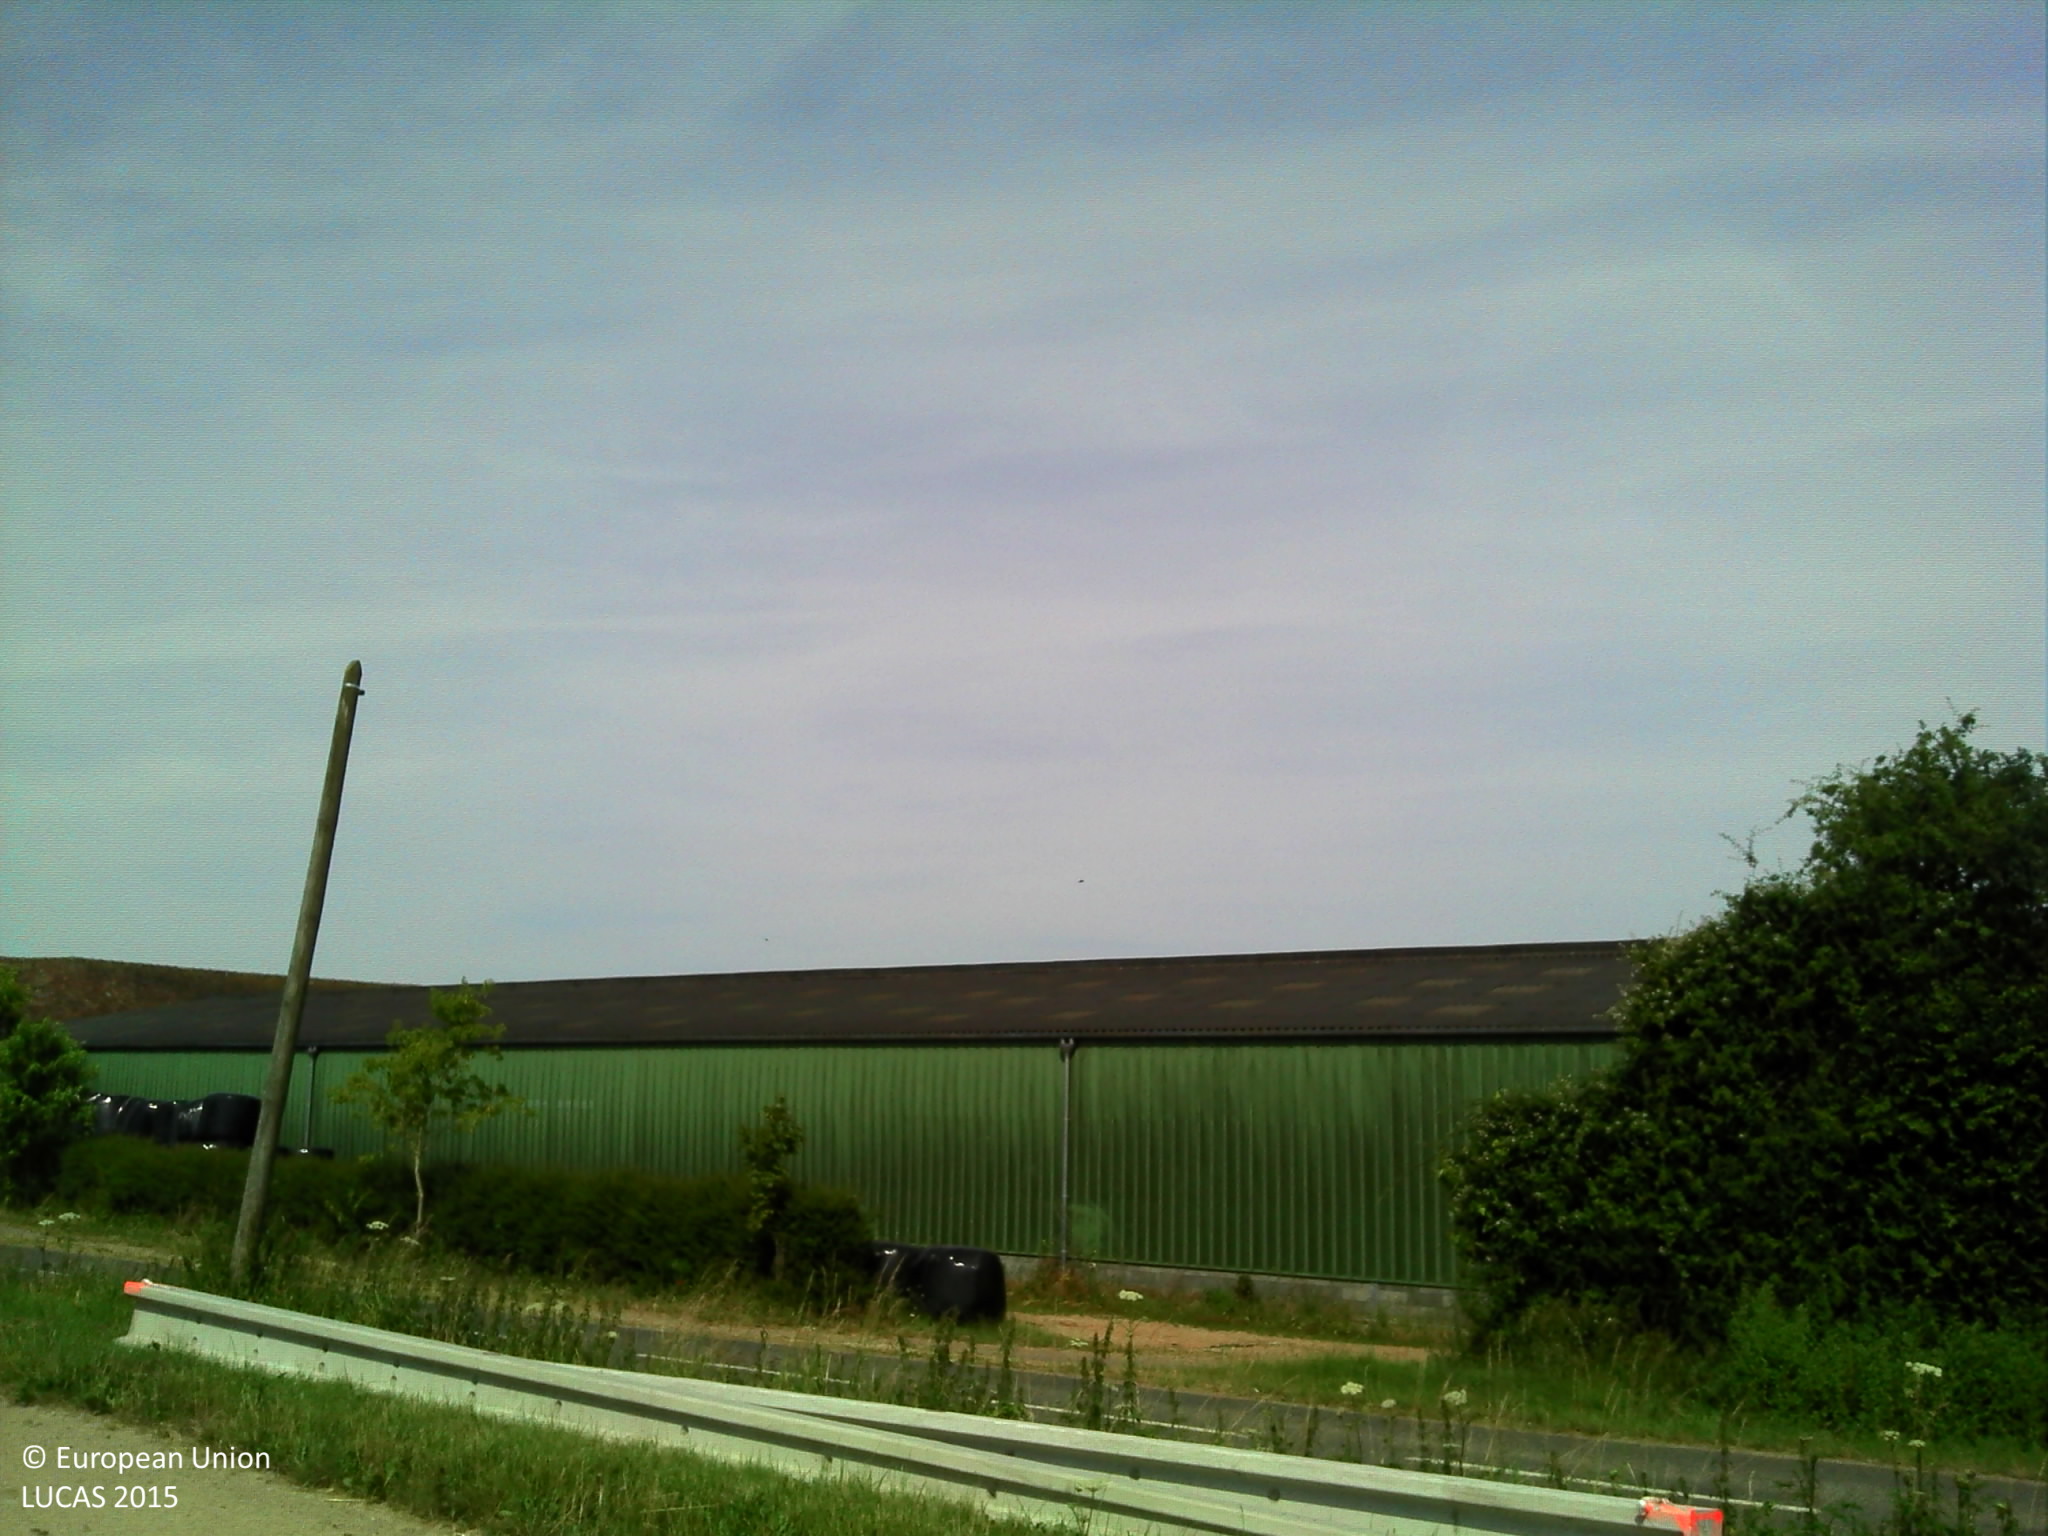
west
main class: Cropland
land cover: Maize
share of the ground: 25 - 50 %
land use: Agriculture (excluding fallow land and kitchen gardens)
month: June
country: FR
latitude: 48.4335
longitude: 0.1459
